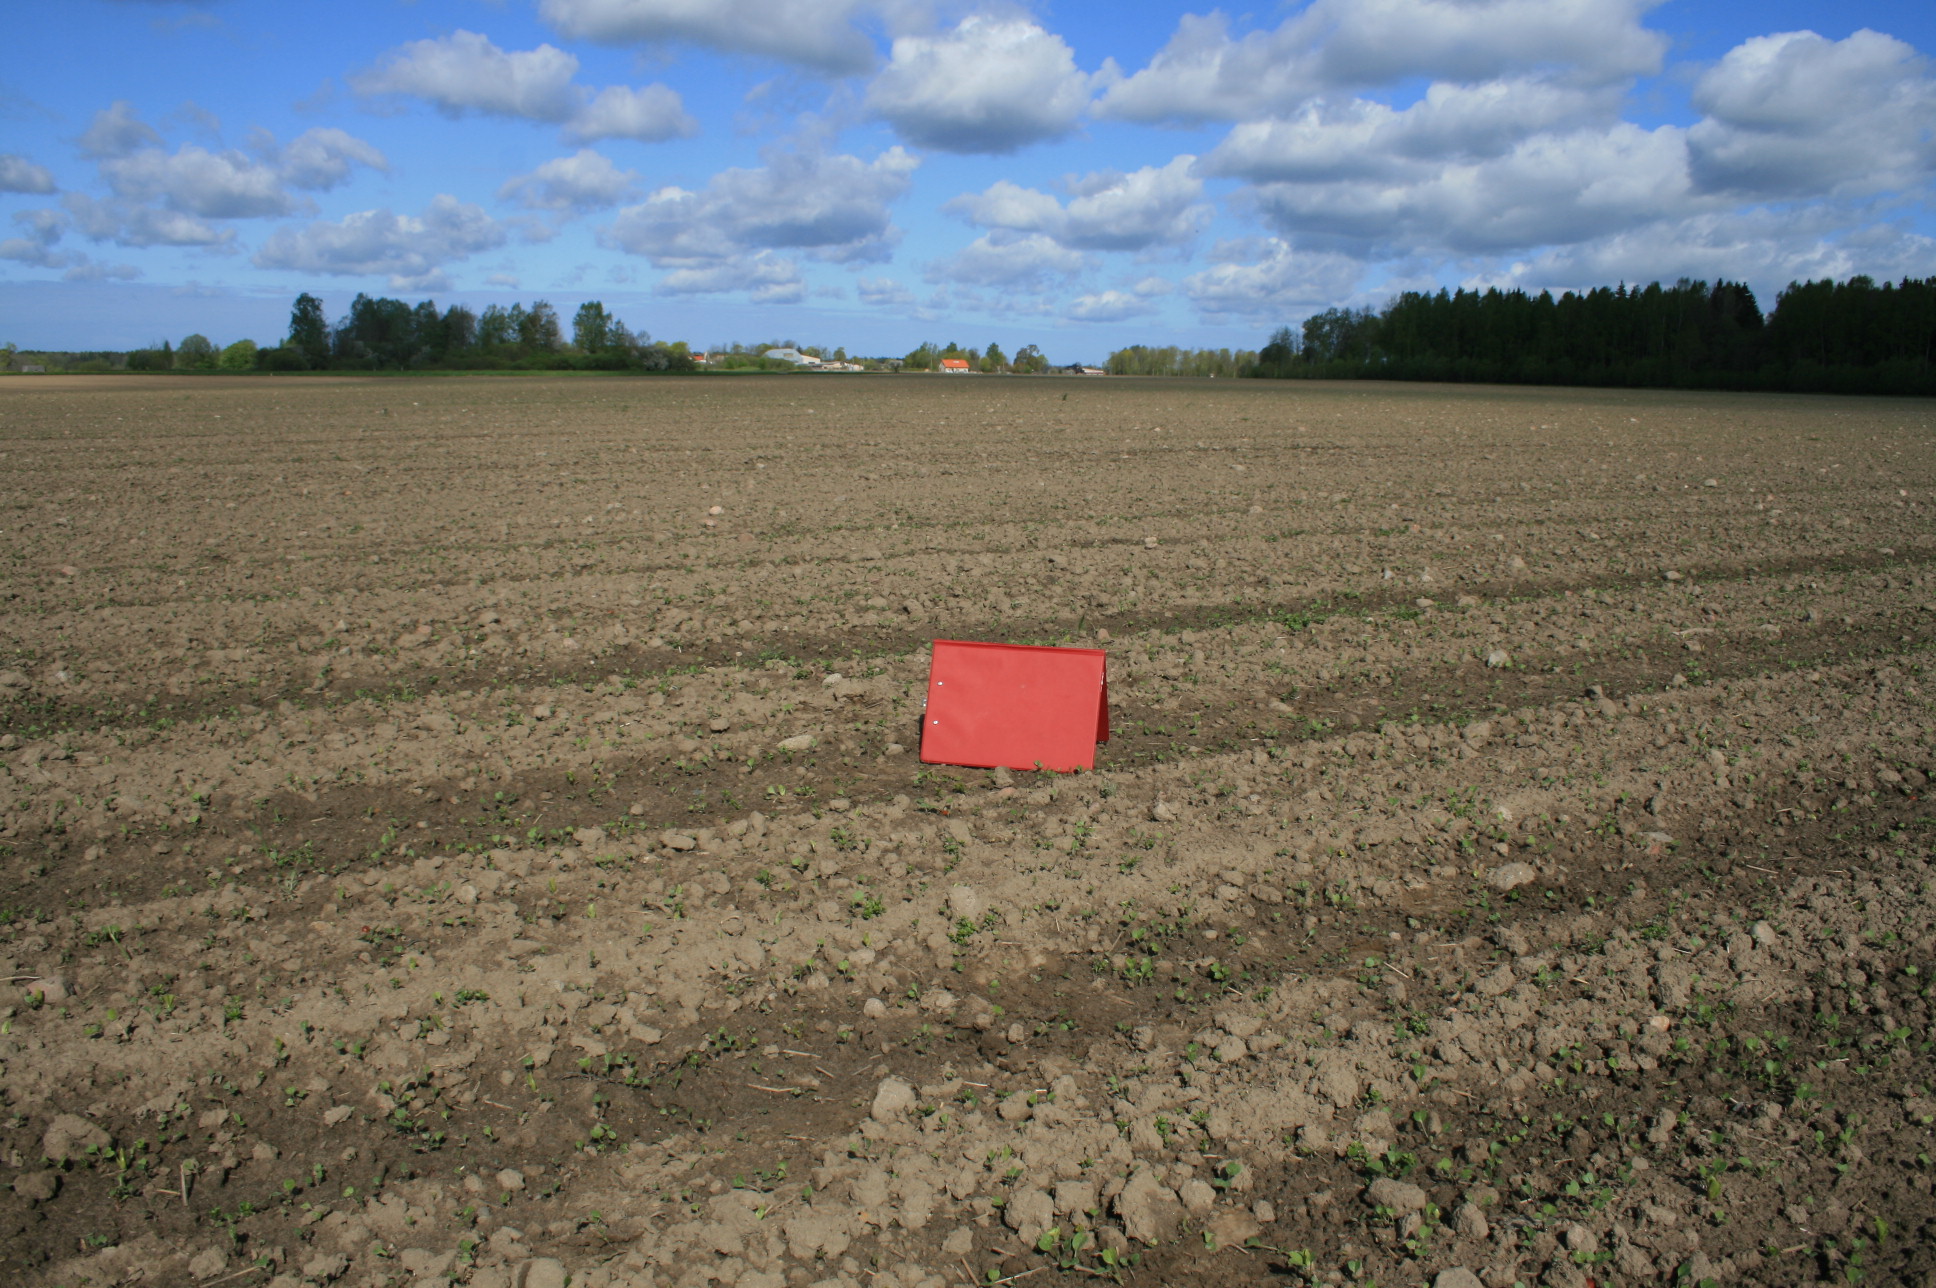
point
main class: Cropland
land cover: Dry pulses
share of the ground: < 10 %
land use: Agriculture (excluding fallow land and kitchen gardens)
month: May
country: LT
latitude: 56.2284
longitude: 21.5447
